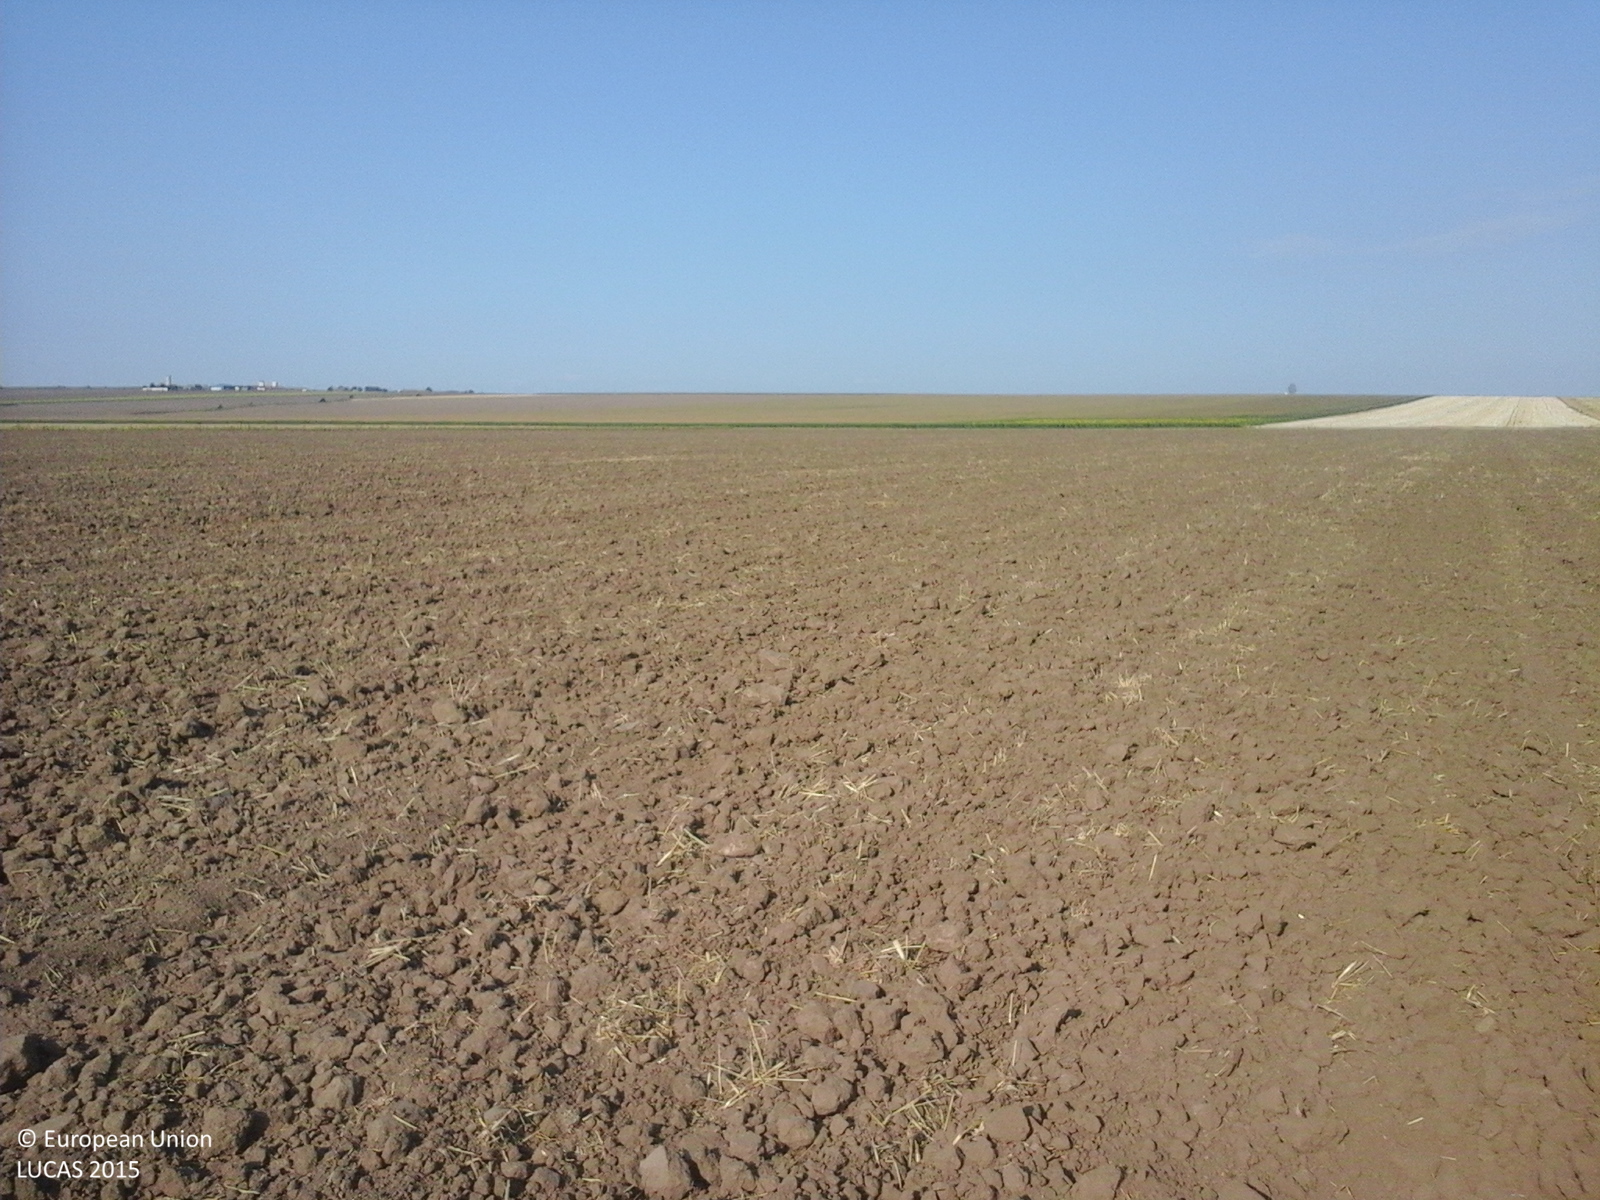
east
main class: Cropland
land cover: Common wheat
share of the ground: < 10 %
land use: Agriculture (excluding fallow land and kitchen gardens)
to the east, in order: Common wheat
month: August
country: RO
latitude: 44.7796
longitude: 28.7761
